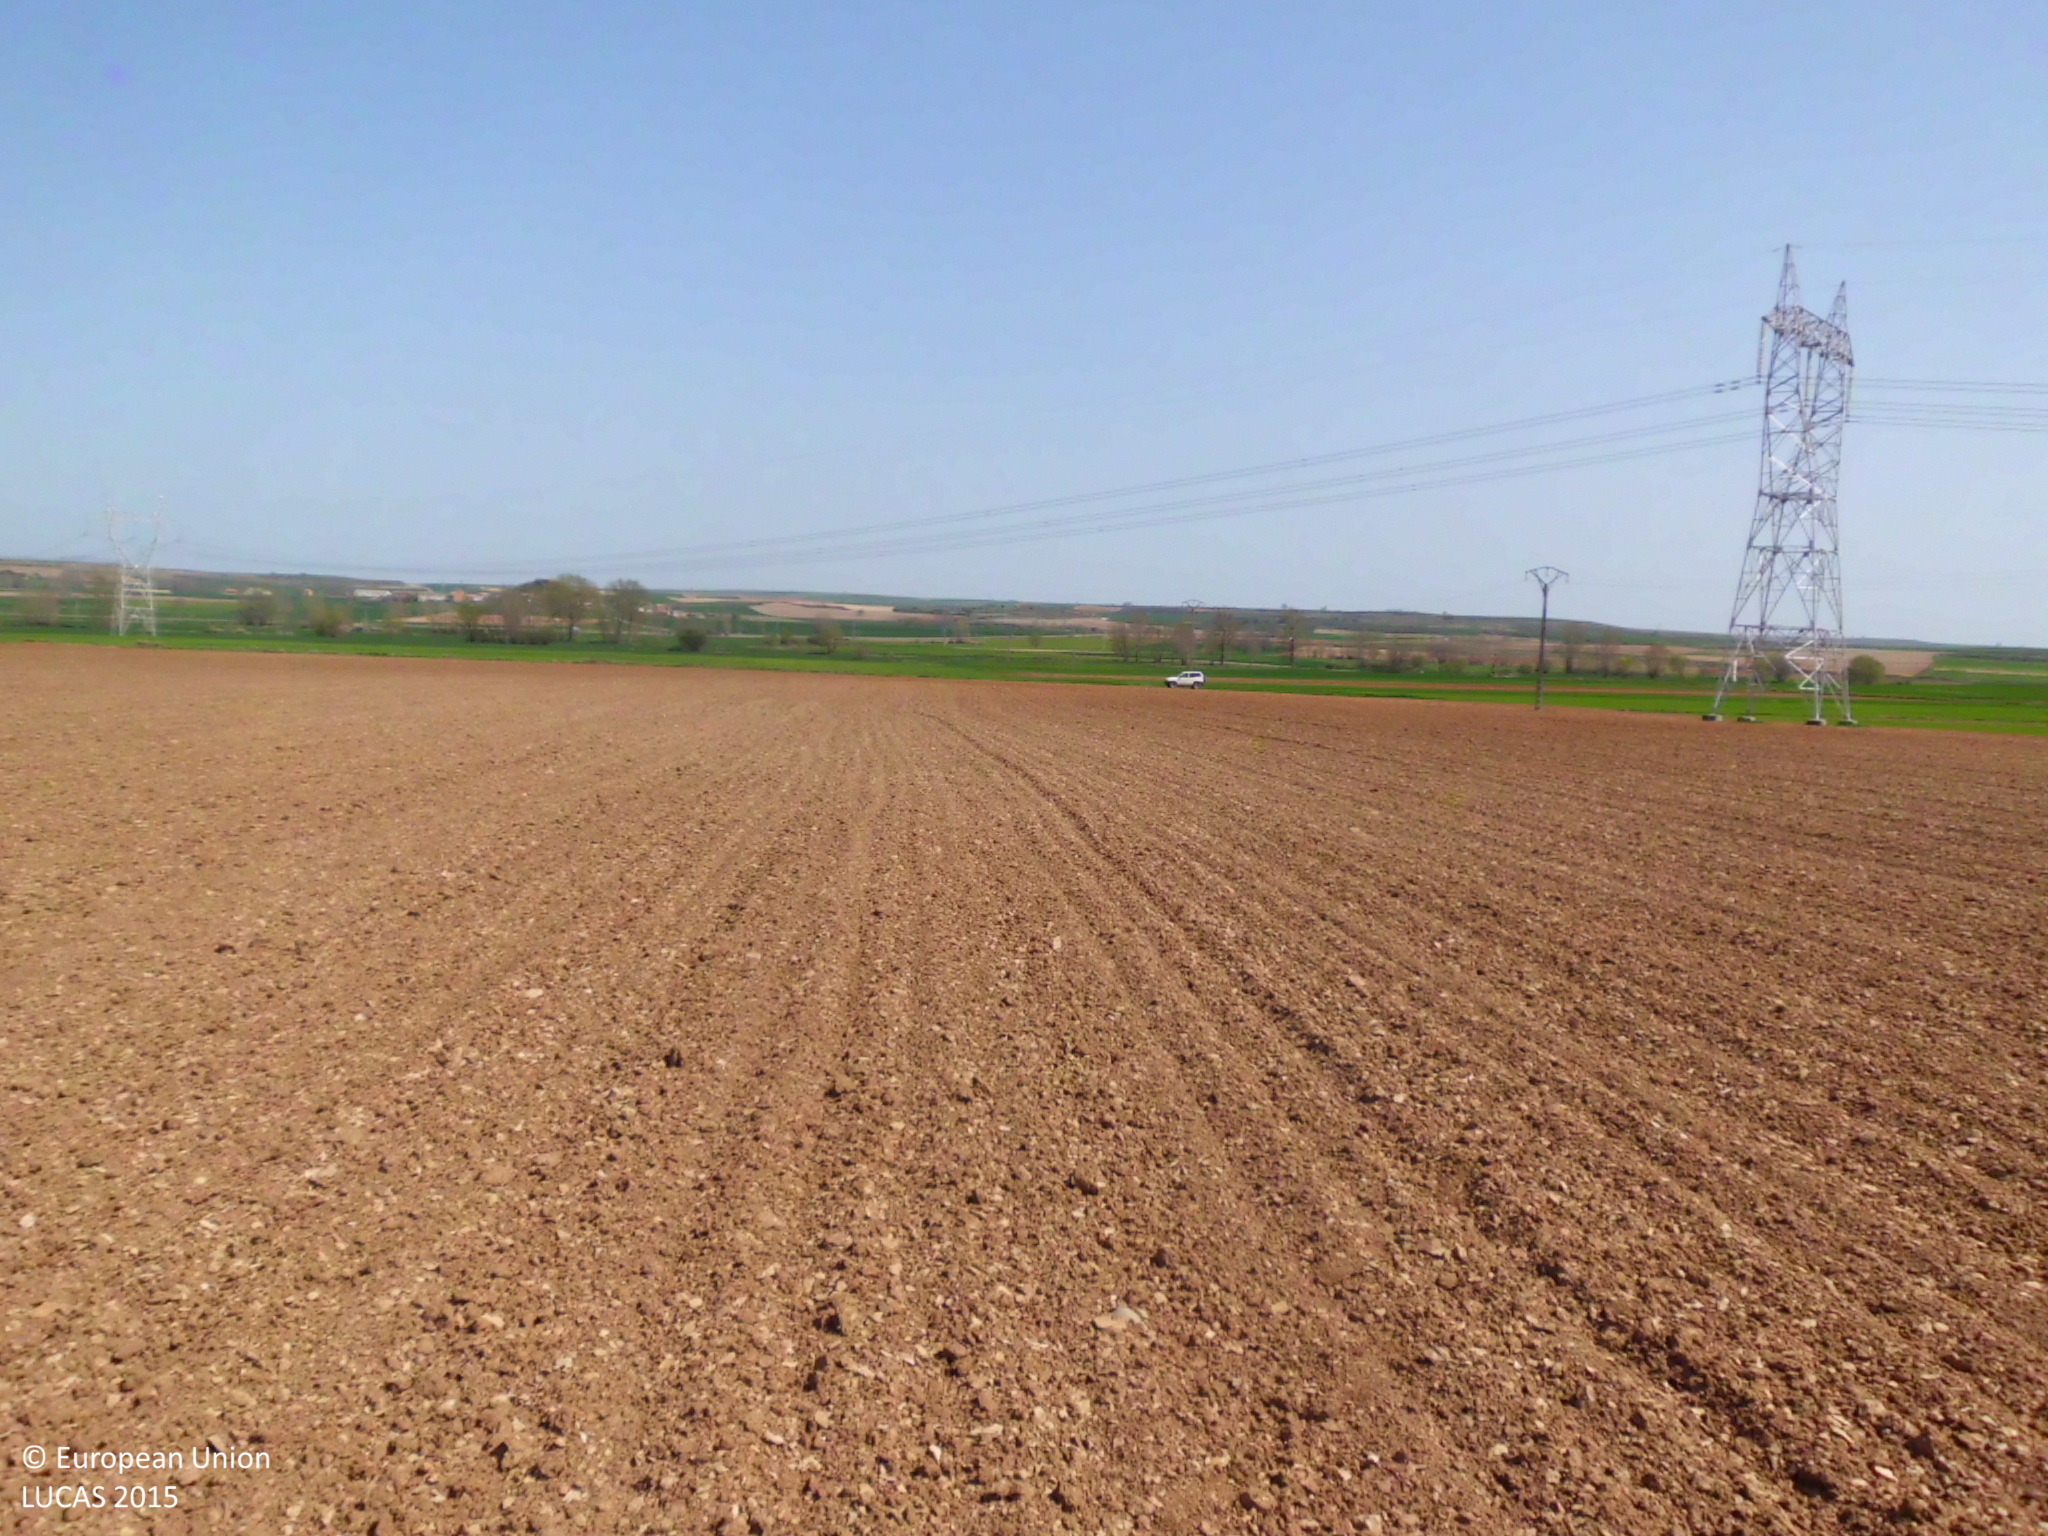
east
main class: Cropland
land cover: Dry pulses
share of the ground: < 10 %
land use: Agriculture (excluding fallow land and kitchen gardens)
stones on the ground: < 10 %
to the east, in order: Dry pulses; Tracks; Barley; Electric lines; Barley
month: April
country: ES
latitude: 42.5880
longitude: -3.3525
